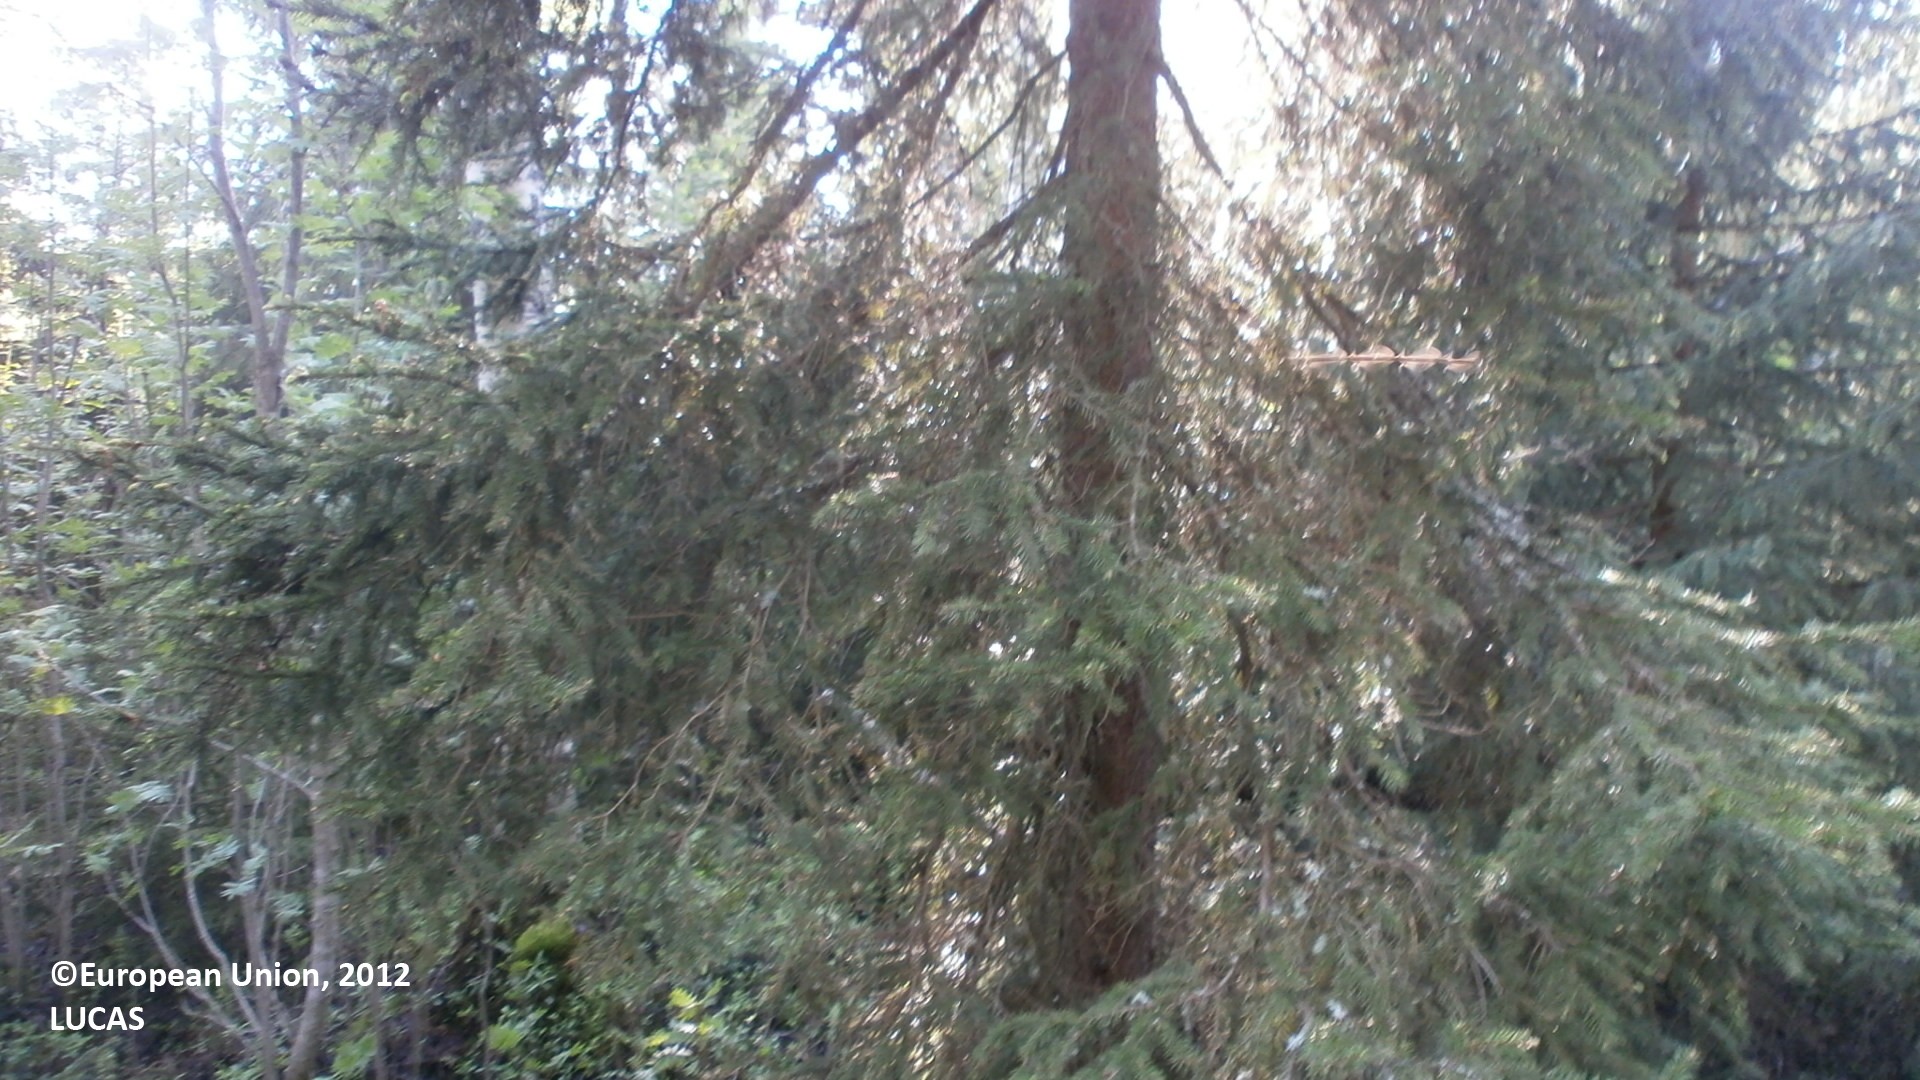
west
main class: Woodland
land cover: Spruce dominated mixed woodland
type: mire and swamp forests
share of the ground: 50 - 75 %
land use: Forestry
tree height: > 5 m
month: June
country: FI
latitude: 64.5989
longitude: 25.2309
